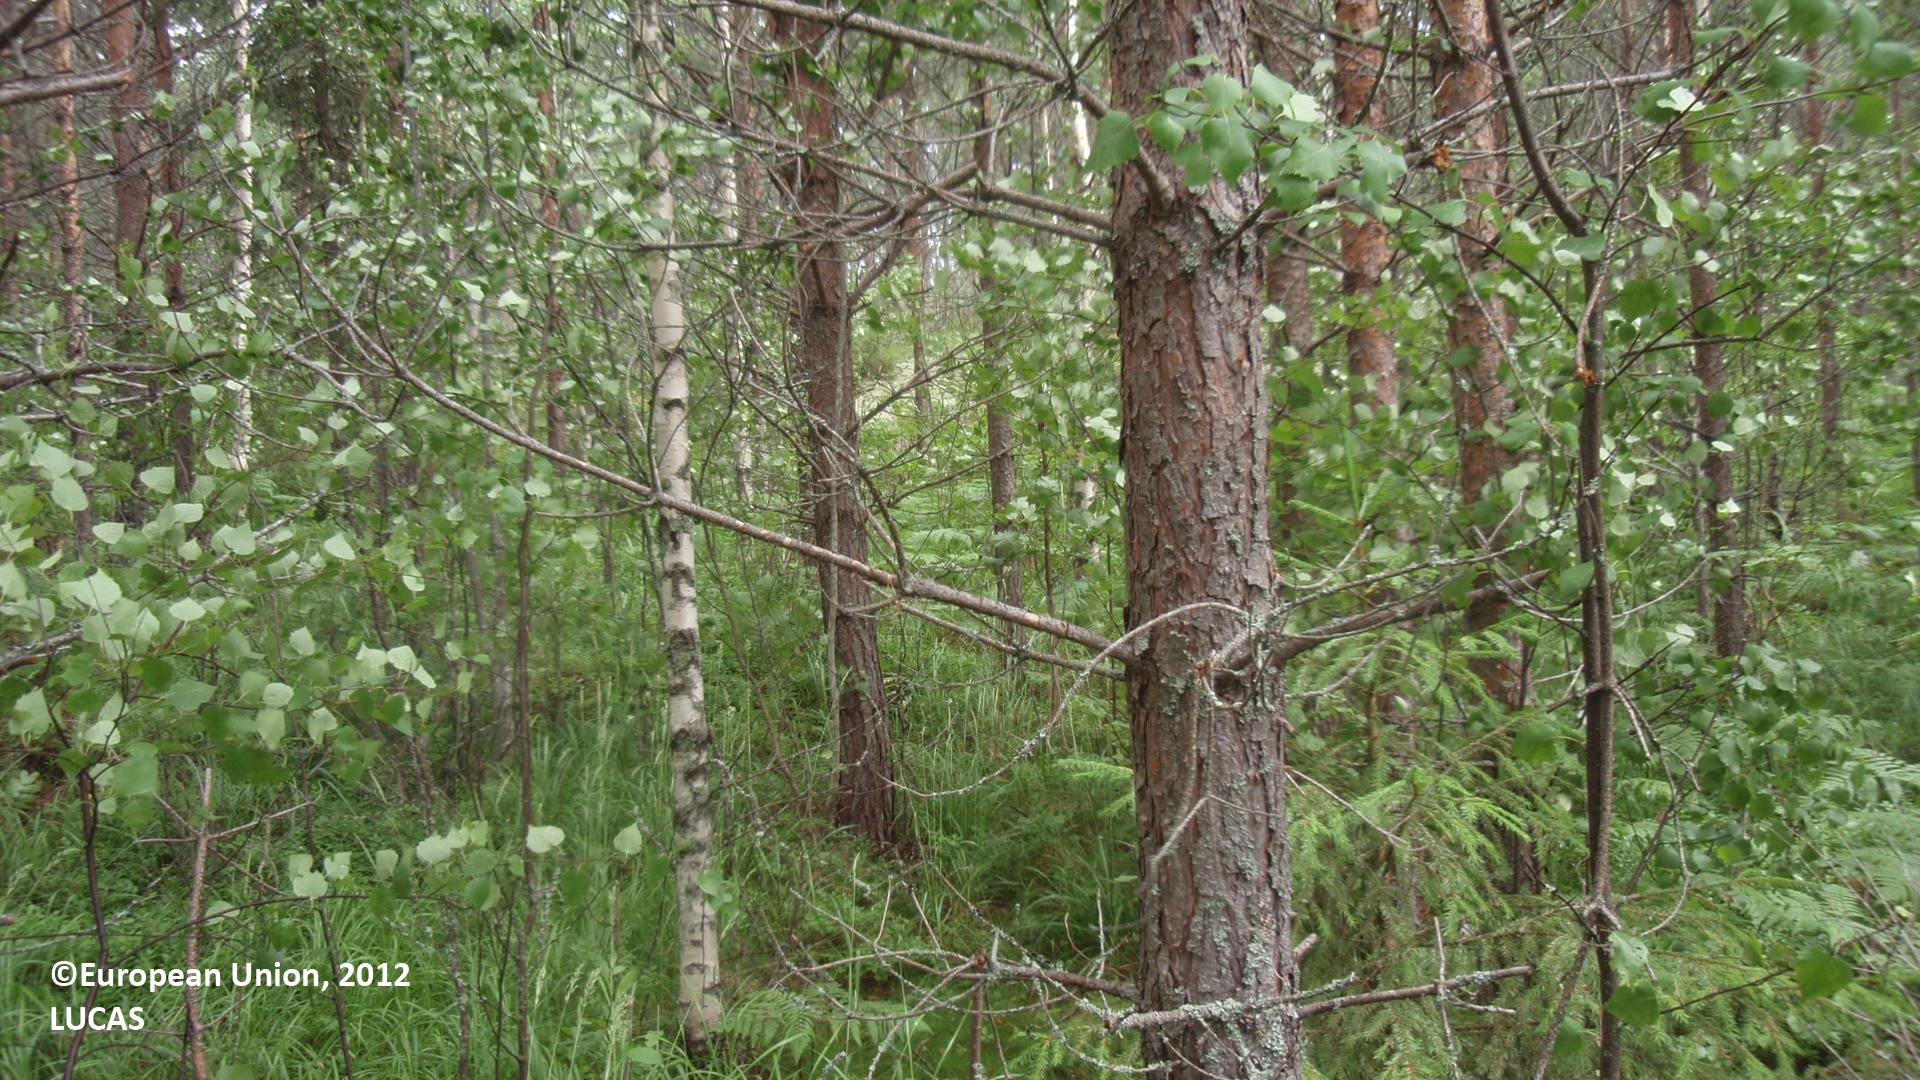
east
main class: Woodland
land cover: Pine dominated mixed woodland
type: boreal forest
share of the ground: 50 - 75 %
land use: Forestry
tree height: > 5 m
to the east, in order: Pine dominated mixed woodland; Pine dominated coniferous woodland; Lichens and moss; Broadleaved woodland; Other mixed woodland; Lichens and moss; Broadleaved woodland
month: July
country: FI
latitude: 61.4487
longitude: 28.4994
